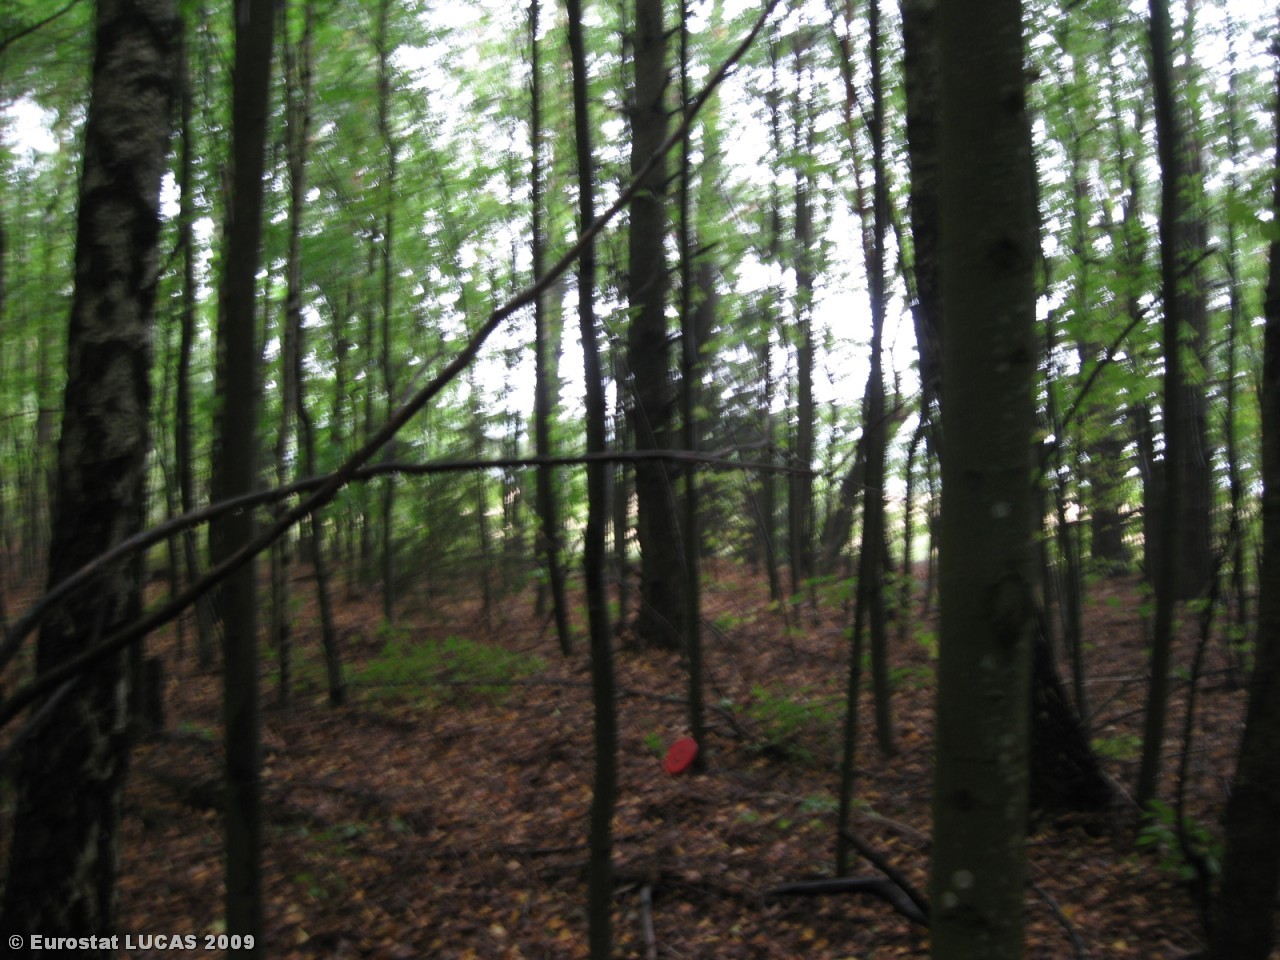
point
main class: Woodland
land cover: Mixed woodland
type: hemiboreal forest and nemoral coniferous forest and mixed broadleaved-coniferous forest
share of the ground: > 75 %
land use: Forestry
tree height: > 5 m
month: September
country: LT
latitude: 54.4226
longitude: 24.6717
